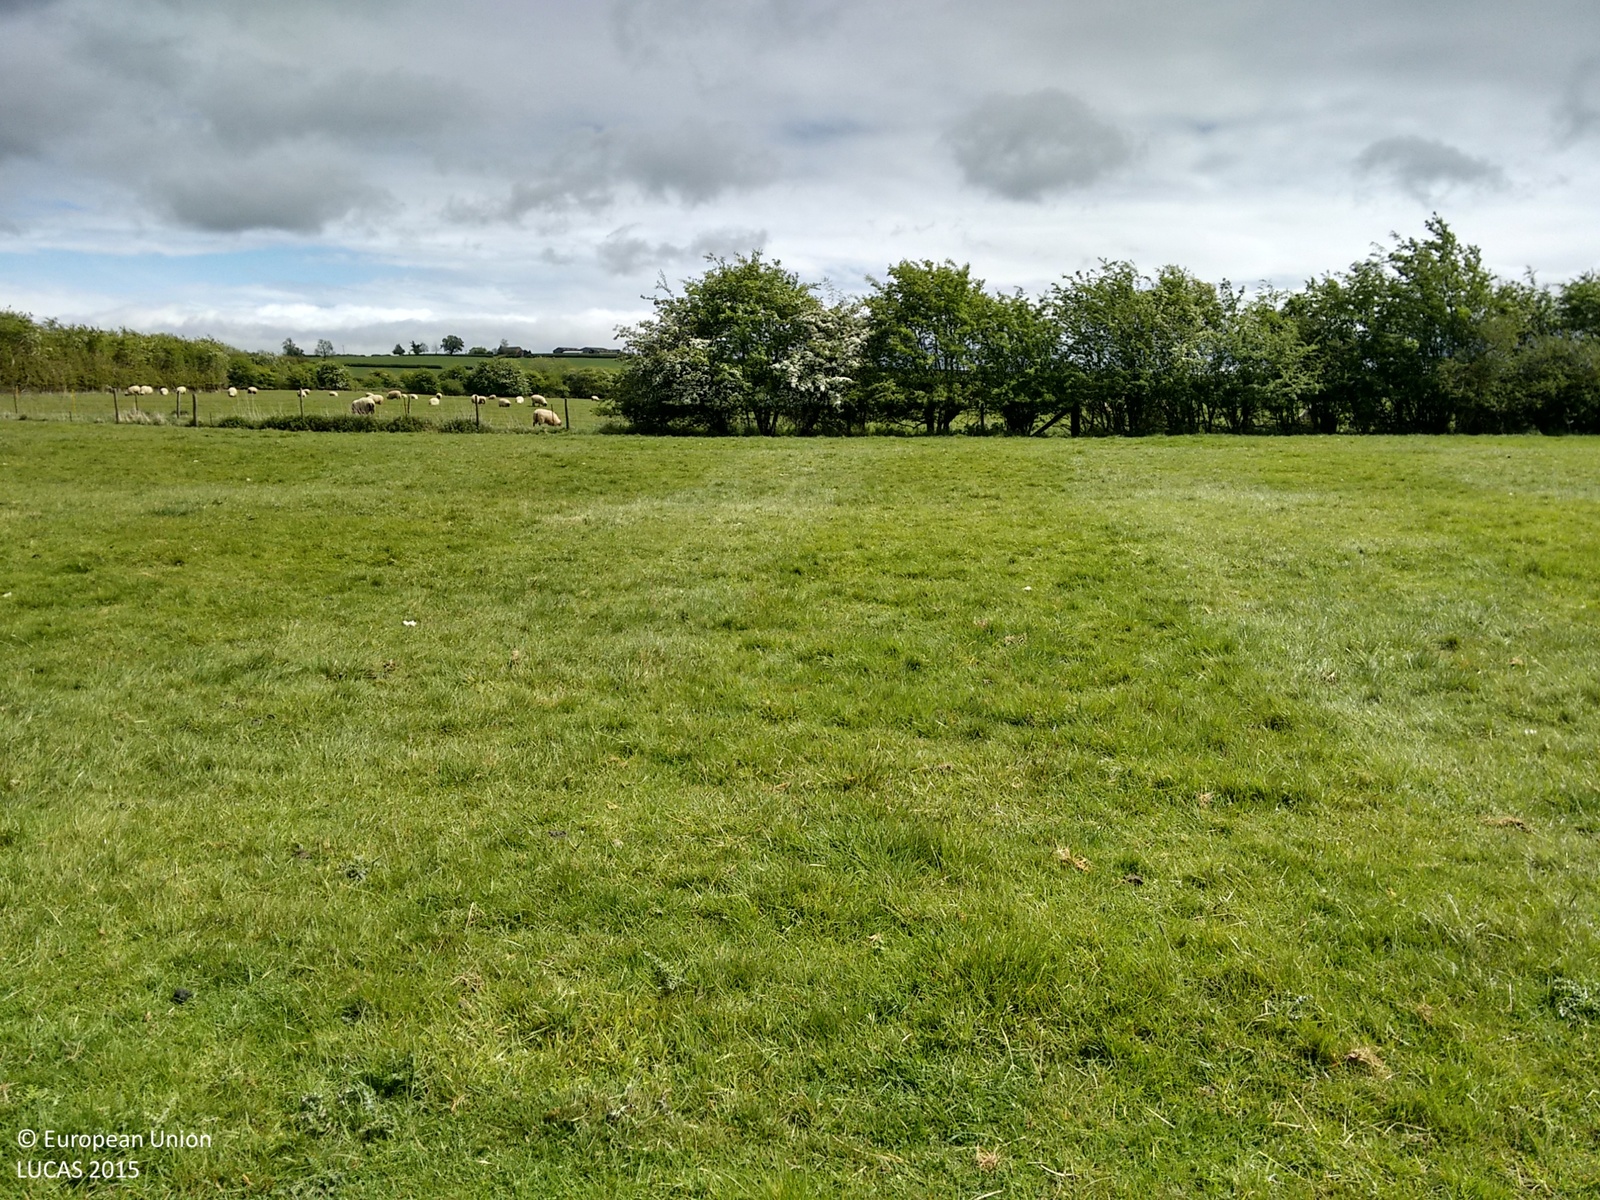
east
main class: Grassland
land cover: Grassland without tree/shrub cover
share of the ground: > 75 %
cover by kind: herbaceous plants 100 %
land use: Agriculture (excluding fallow land and kitchen gardens)
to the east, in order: Grassland without tree/shrub cover; Ditches and canals; Fences; Grass margins; Fences; Grassland without tree/shrub cover
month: May
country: GB
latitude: 52.3139
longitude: -1.2397
